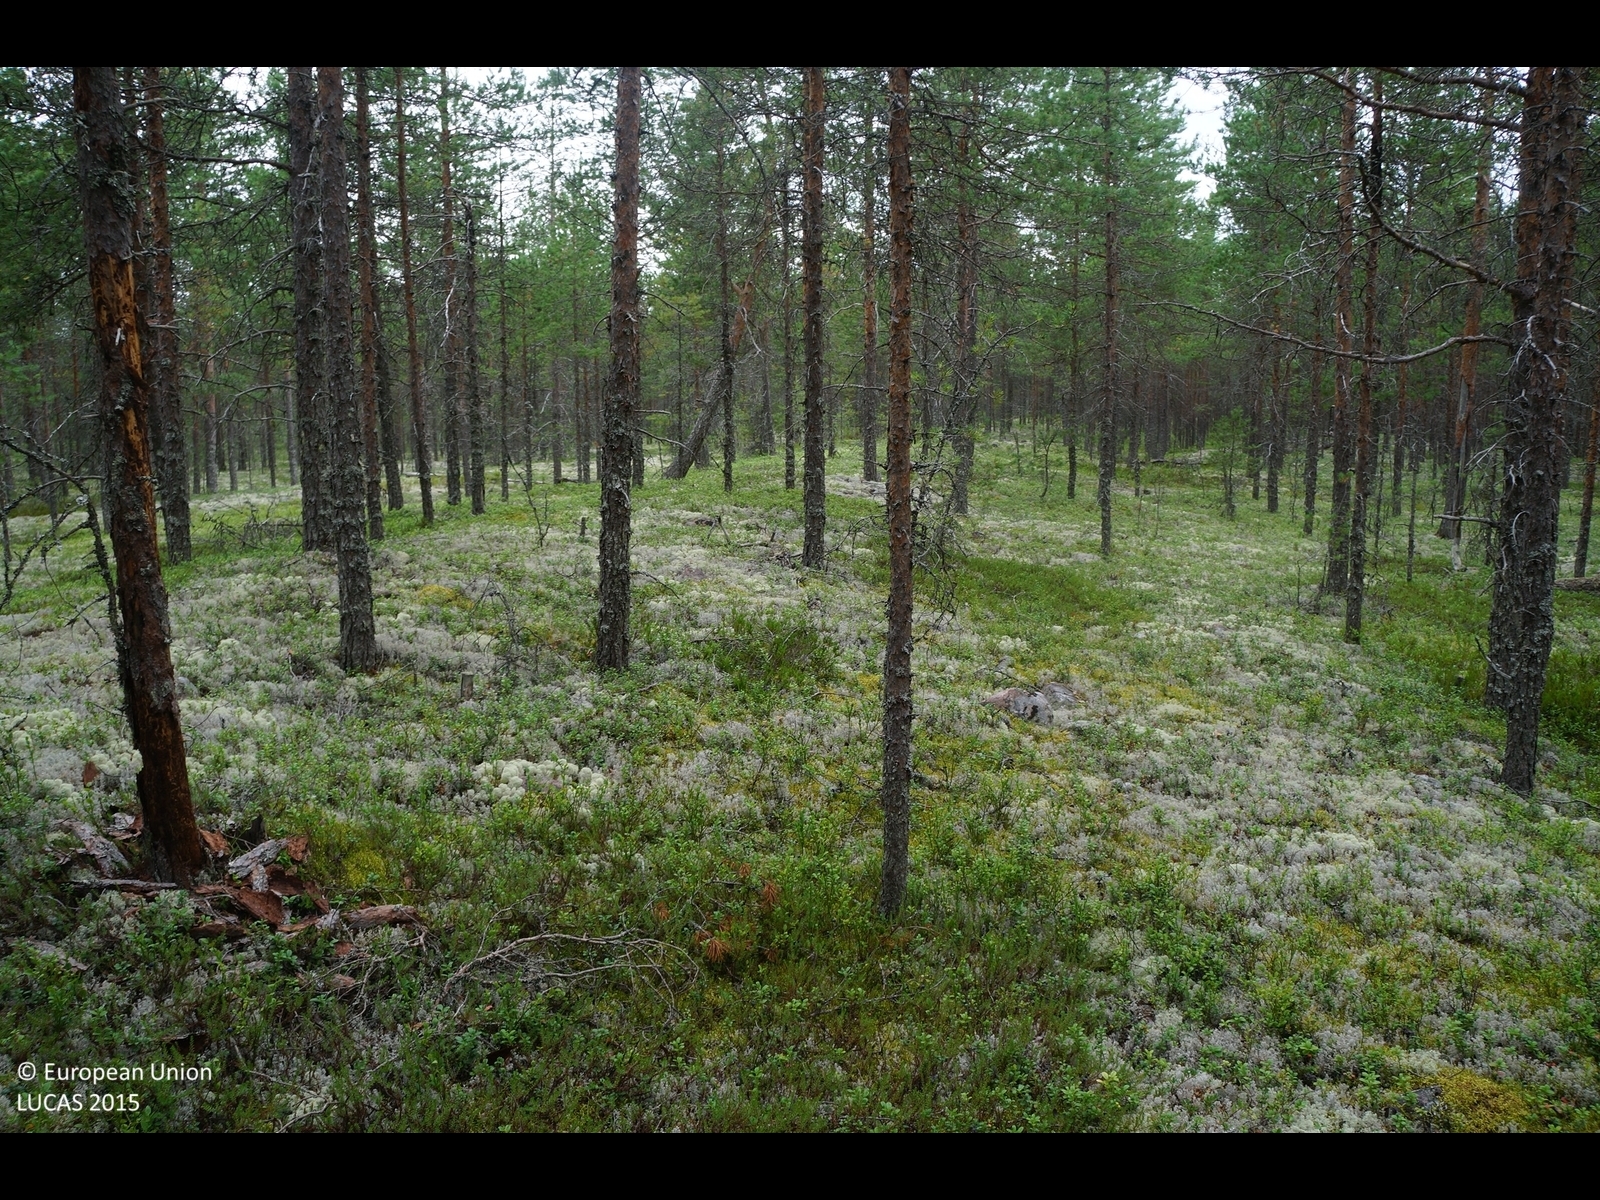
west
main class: Woodland
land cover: Pine dominated coniferous woodland
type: boreal forest
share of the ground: 50 - 75 %
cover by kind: coniferous forest trees 50 %, lichens and mosses 35 %, shrubs 15 %
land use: Forestry
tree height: > 5 m
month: August
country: FI
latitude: 64.8131
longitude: 24.9209
